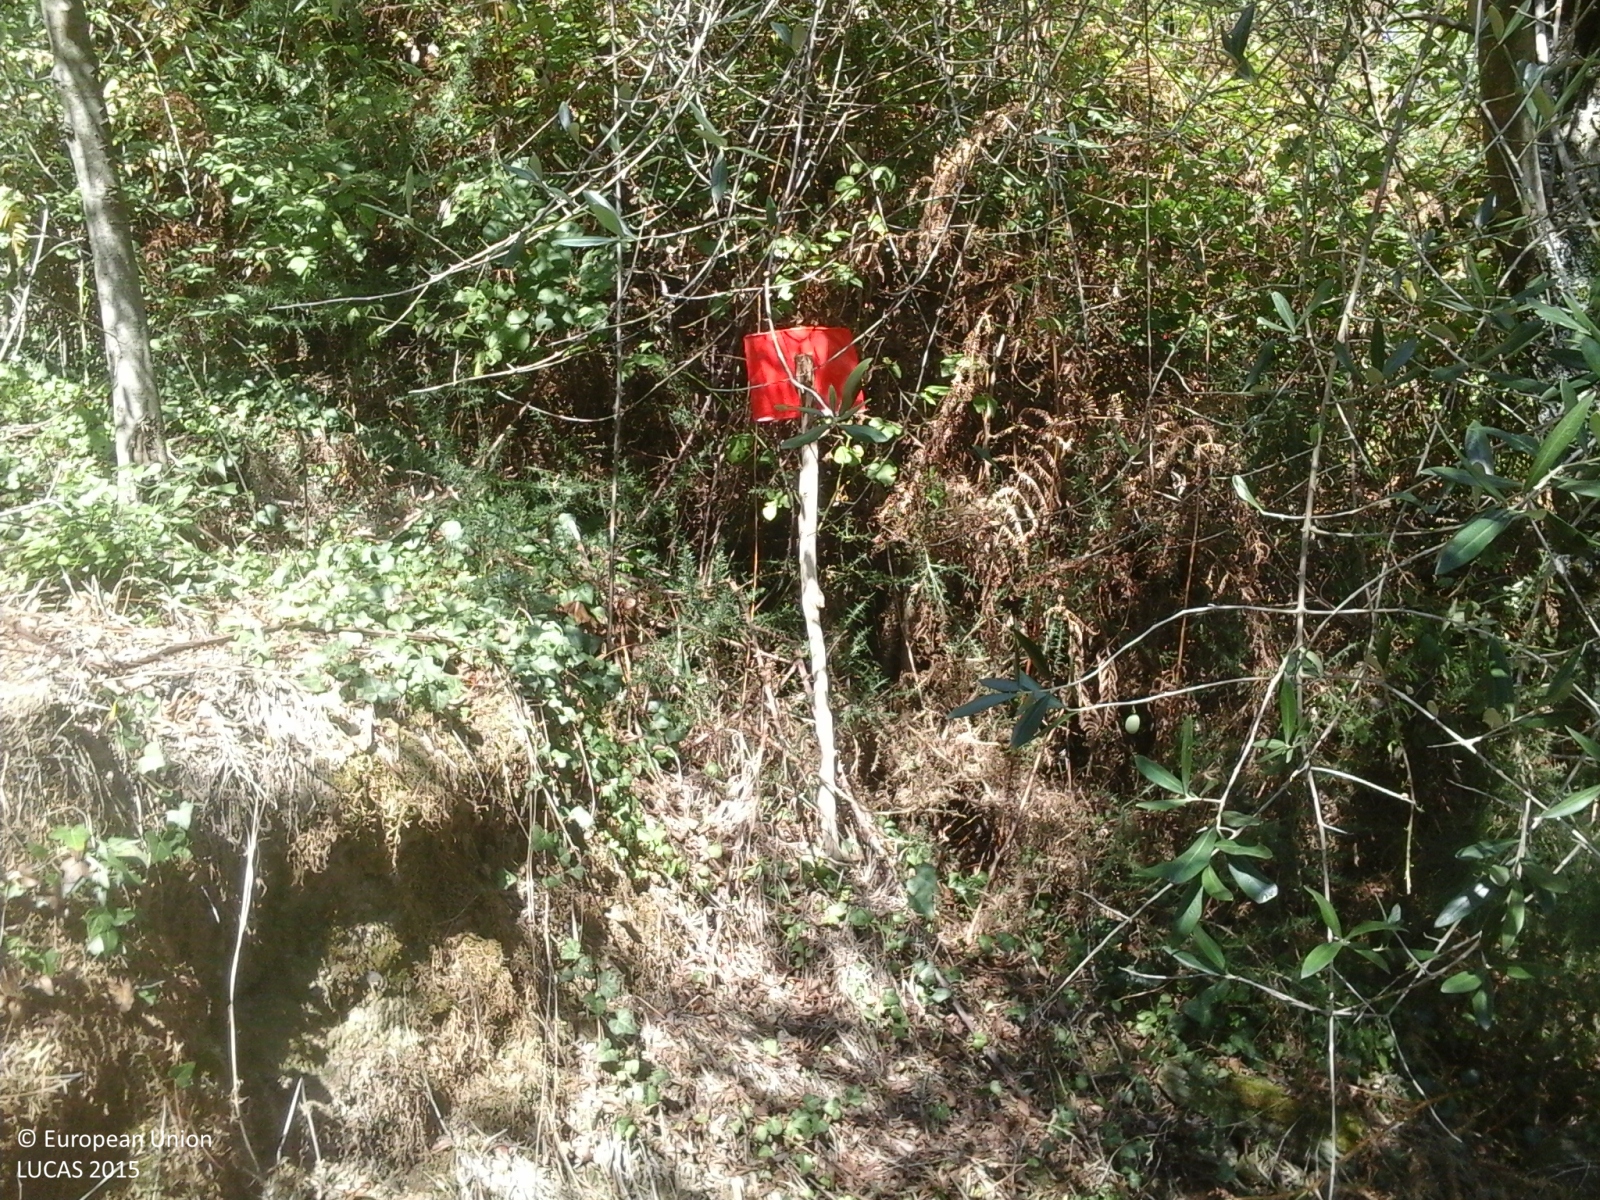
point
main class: Cropland
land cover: Olive groves
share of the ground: > 75 %
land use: Agriculture (excluding fallow land and kitchen gardens)
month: August
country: IT
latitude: 43.7354
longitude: 10.6067
